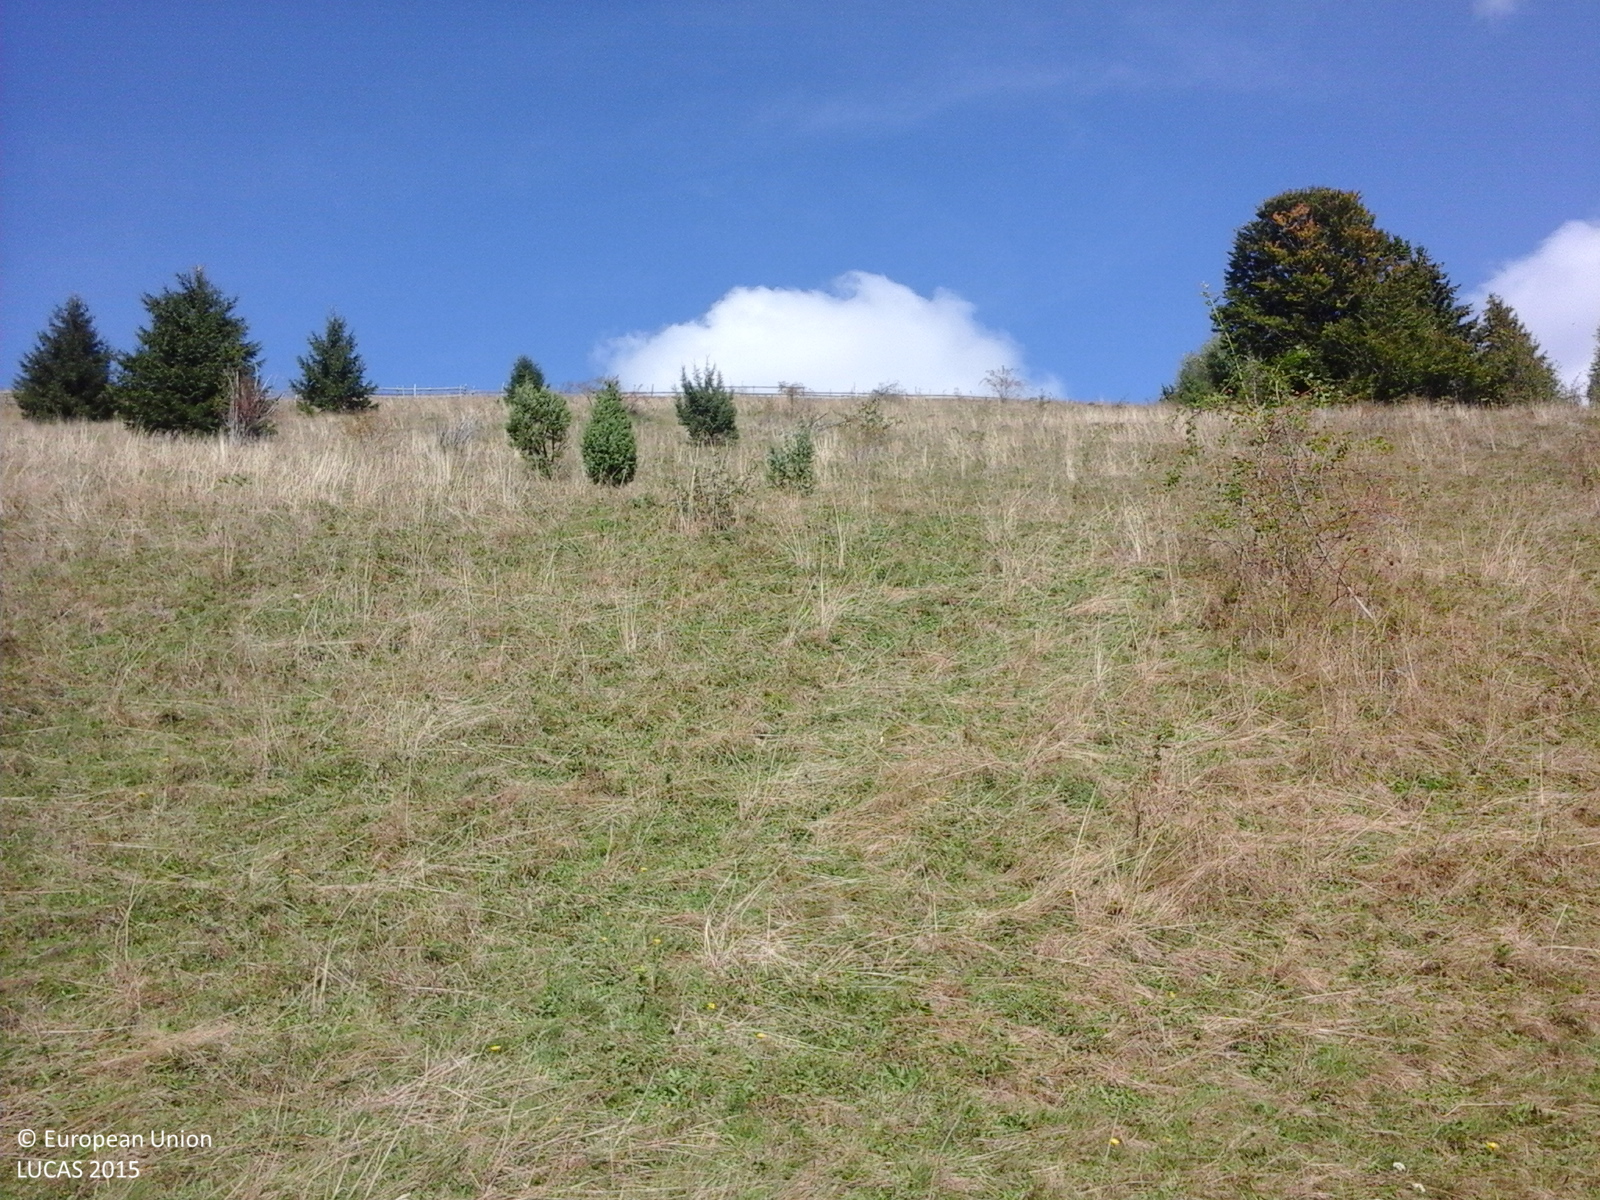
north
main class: Grassland
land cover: Grassland without tree/shrub cover
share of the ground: > 75 %
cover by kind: herbaceous plants 100 %
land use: Agriculture (excluding fallow land and kitchen gardens)
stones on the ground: < 10 %
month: October
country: RO
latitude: 46.4092
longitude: 23.1610
